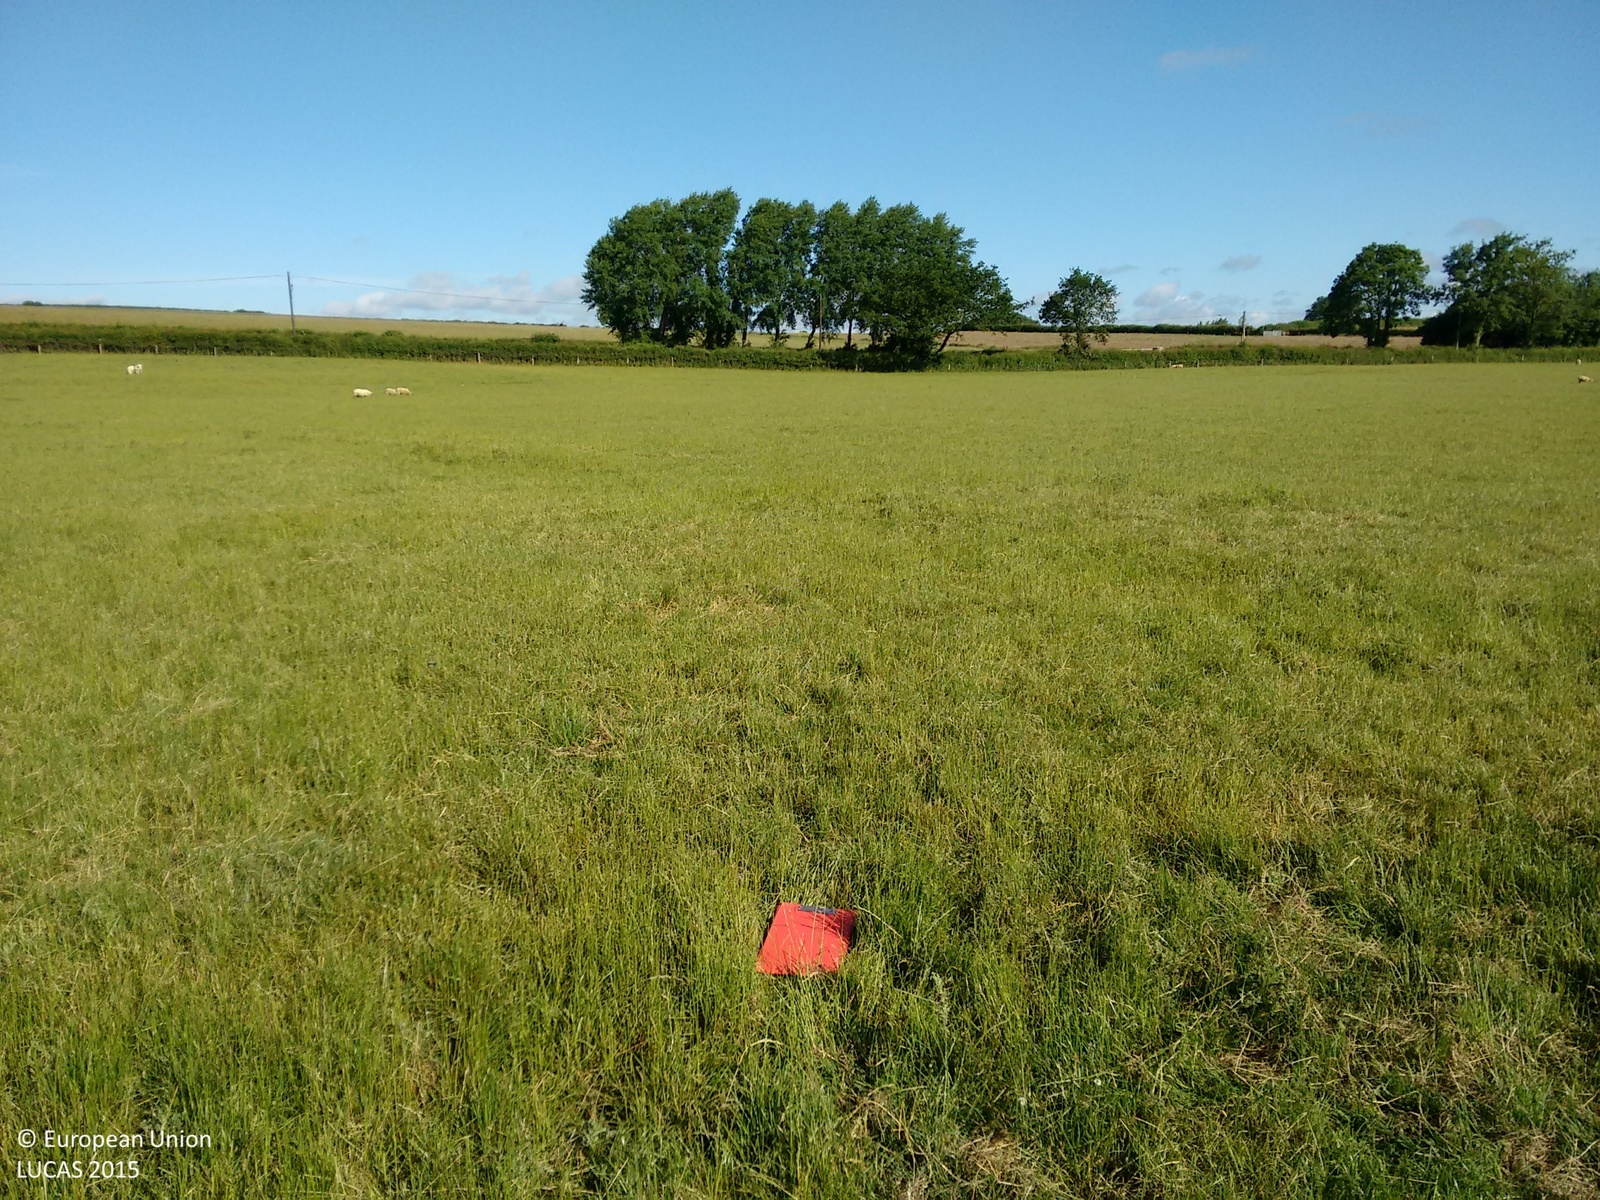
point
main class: Grassland
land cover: Grassland without tree/shrub cover
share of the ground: > 75 %
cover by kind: herbaceous plants 100 %
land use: Agriculture (excluding fallow land and kitchen gardens)
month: July
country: IE
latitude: 52.5299
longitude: -7.2958
